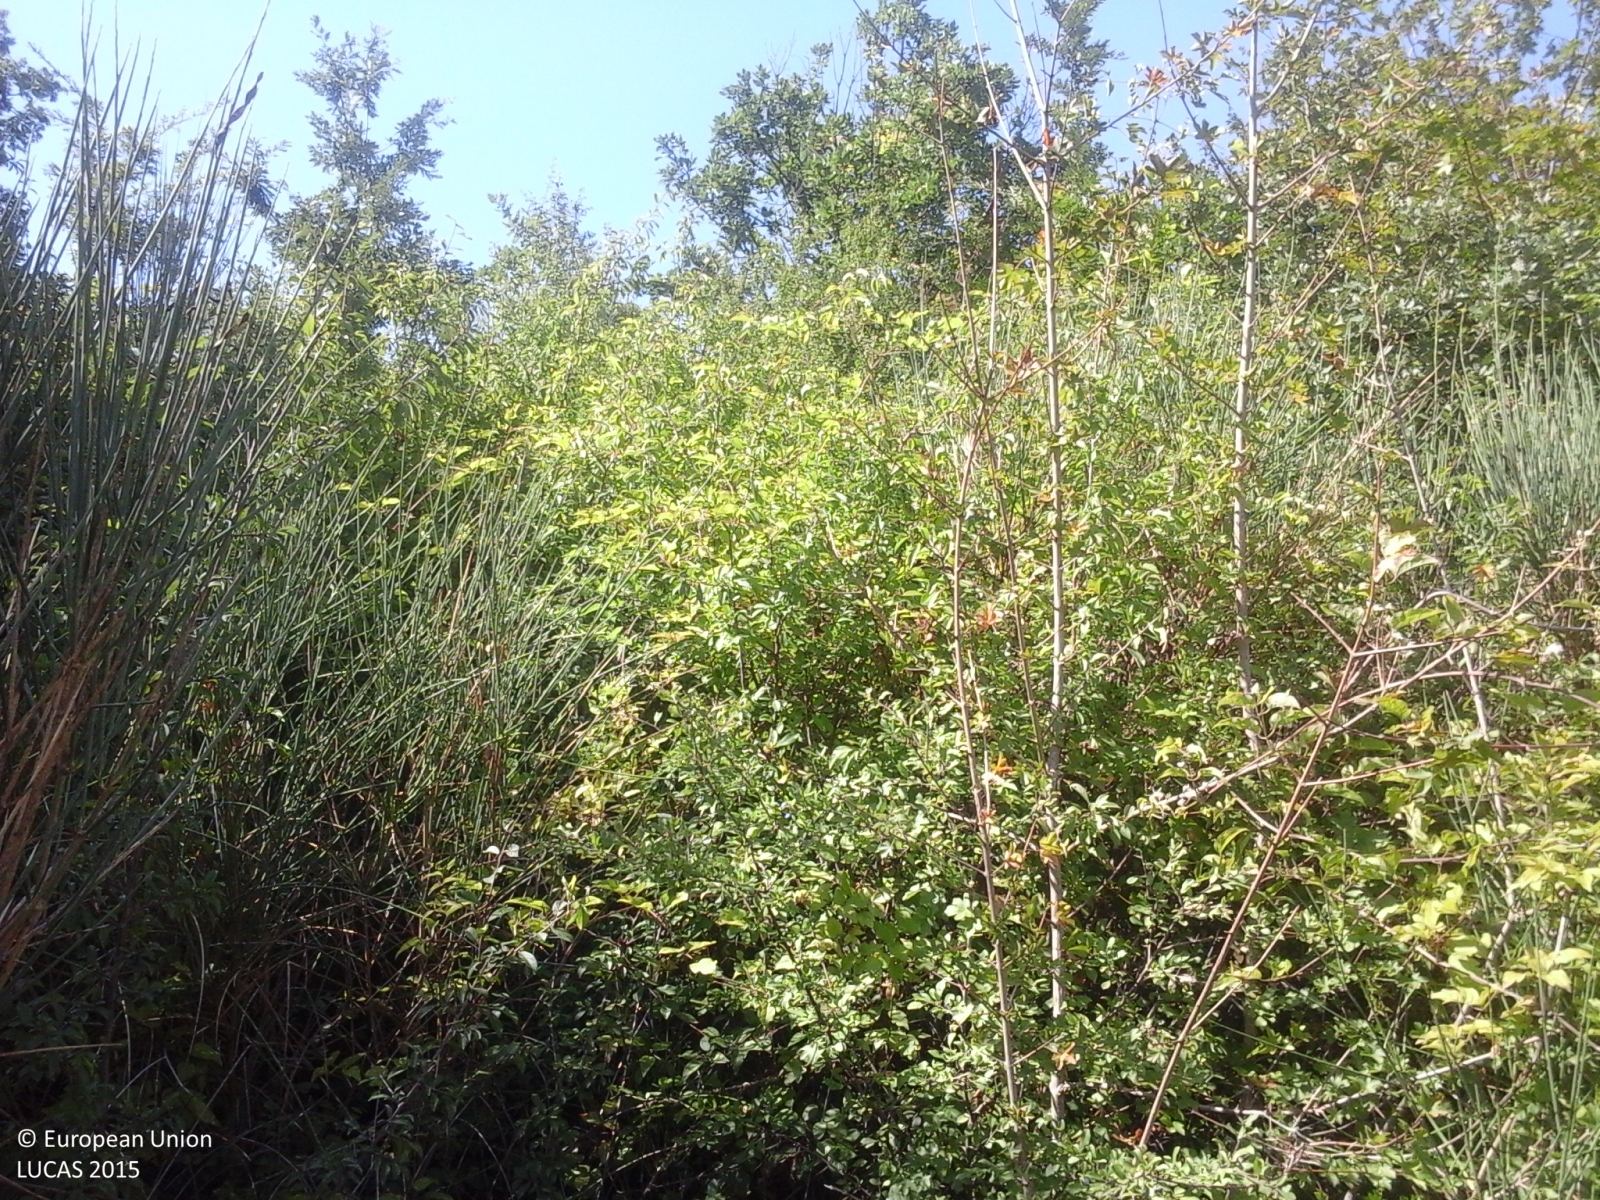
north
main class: Woodland
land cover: Broadleaved woodland
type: thermophilous deciduous forest
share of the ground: > 75 %
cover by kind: broadleaved forest trees 80 %, shrubs 20 %
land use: Forestry
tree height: < 5 m
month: August
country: IT
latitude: 42.6438
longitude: 12.3950
